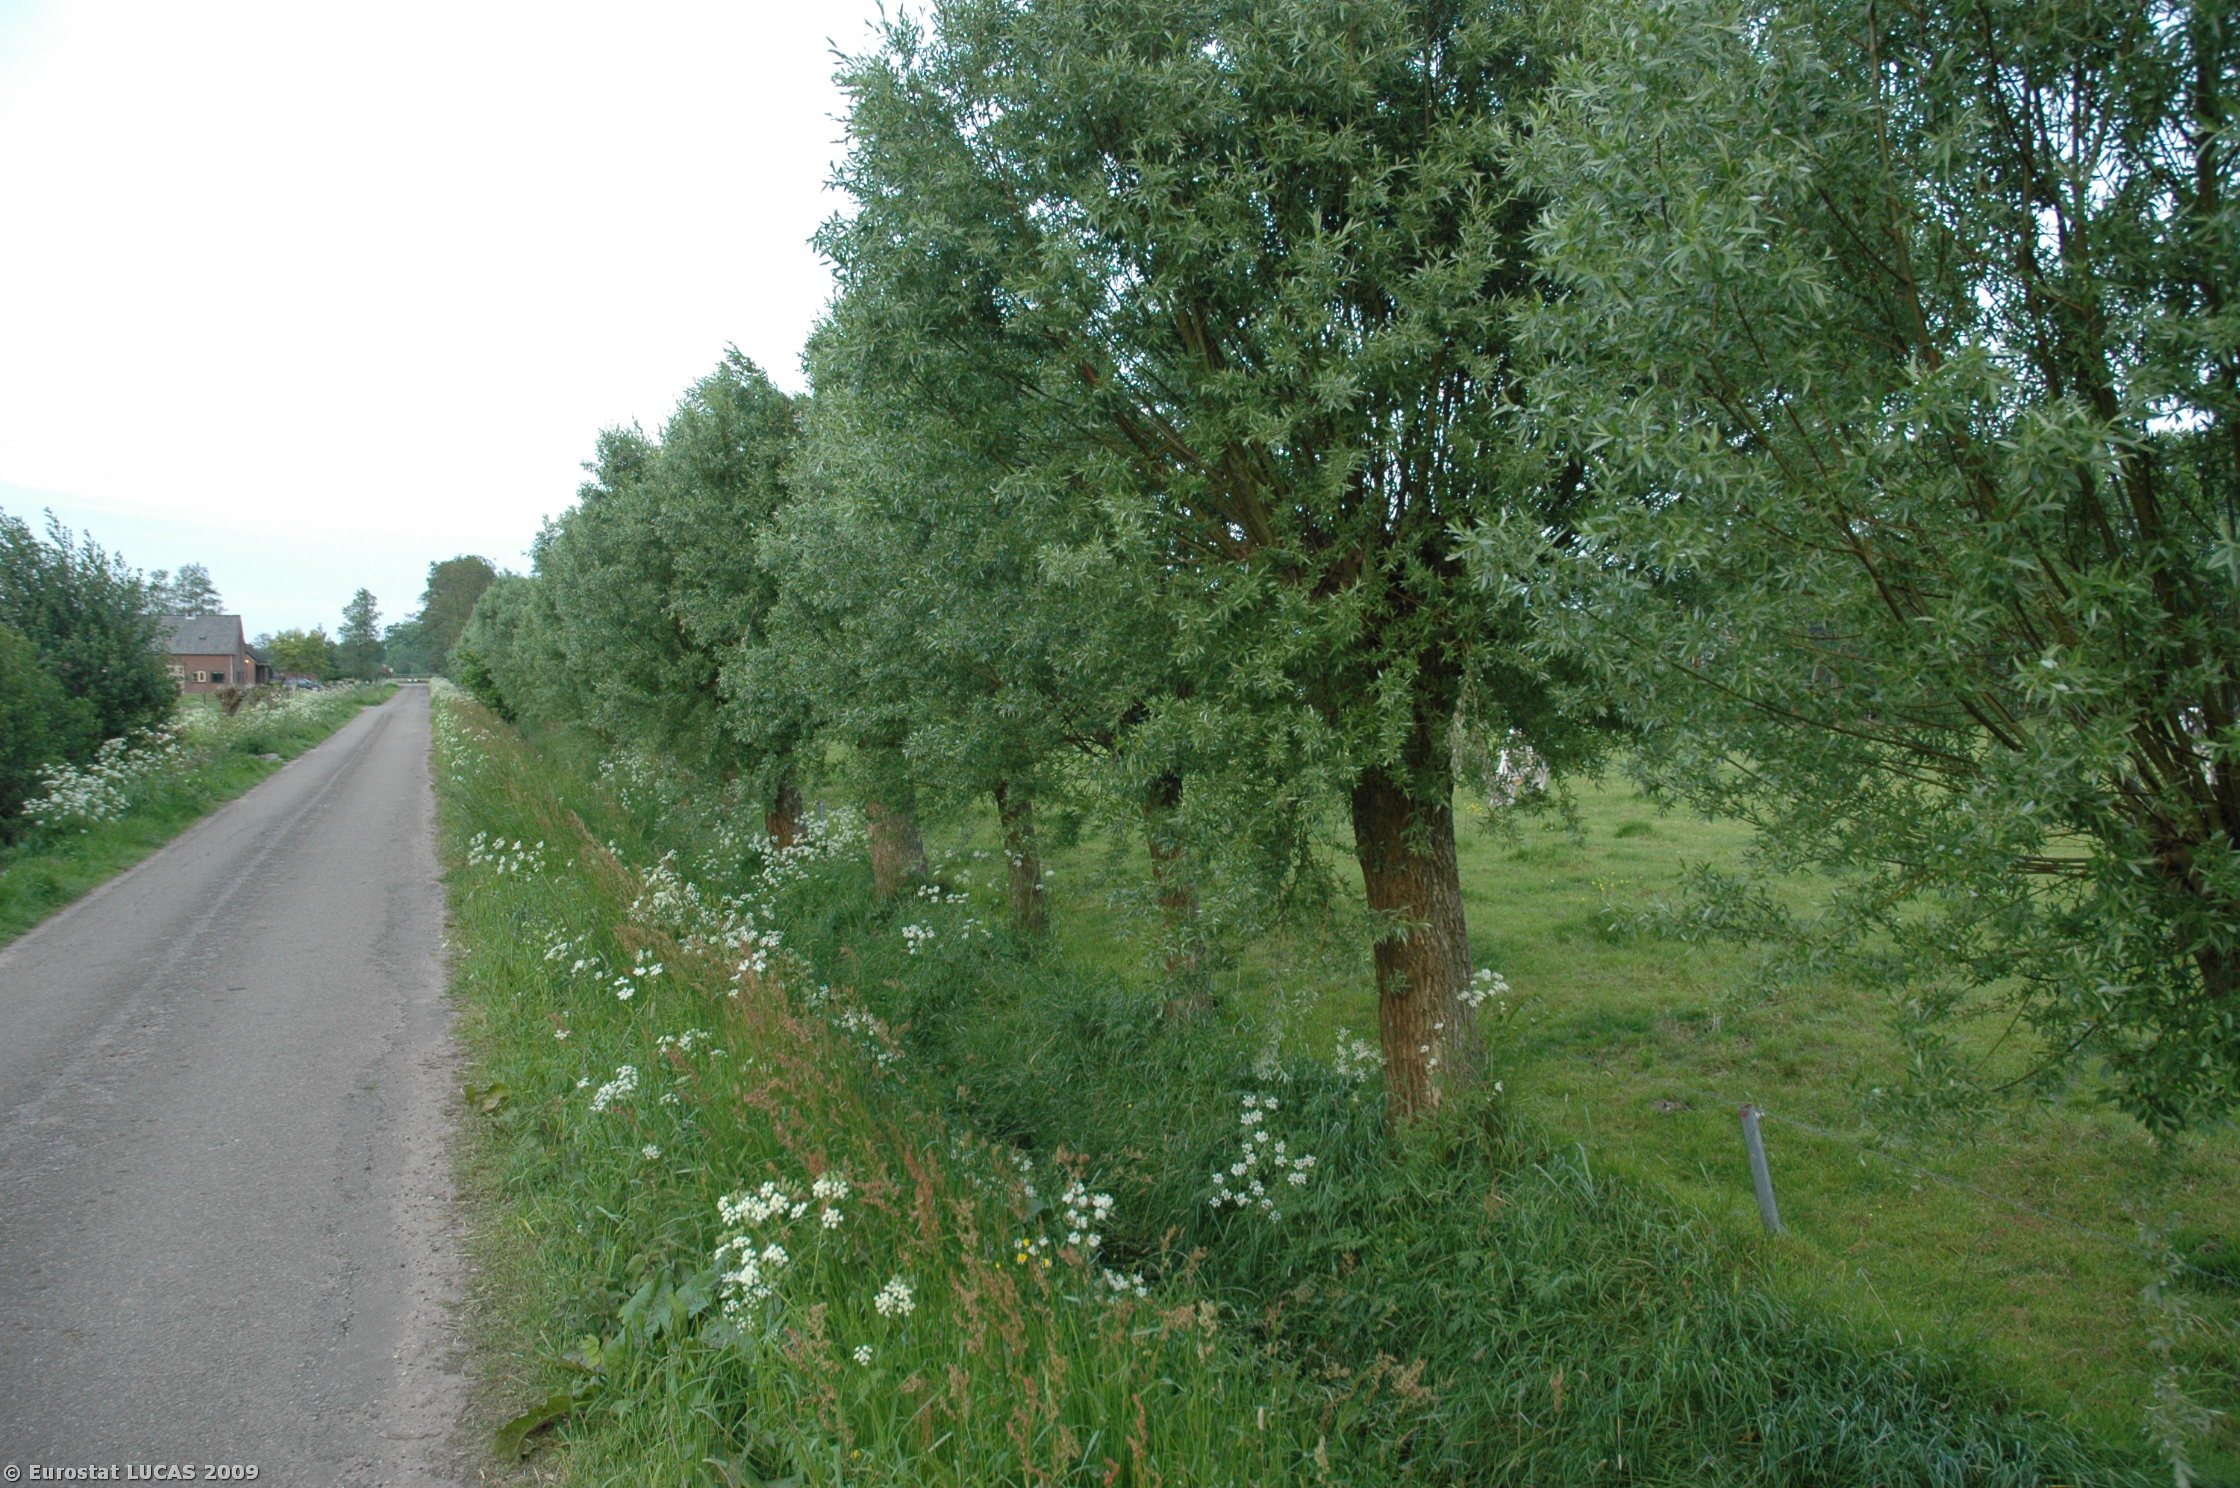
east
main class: Grassland
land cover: Grassland without tree/shrub cover
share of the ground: > 75 %
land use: Agriculture (excluding fallow land and kitchen gardens)
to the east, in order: Grassland without tree/shrub cover; Artificial constructions in urban areas; Grassland without tree/shrub cover; Fences; Grassland without tree/shrub cover; Fences; Ditches and canals; Fences; Broadleaved woodland; Grassland without tree/shrub cover
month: May
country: NL
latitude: 52.0724
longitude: 5.4024
